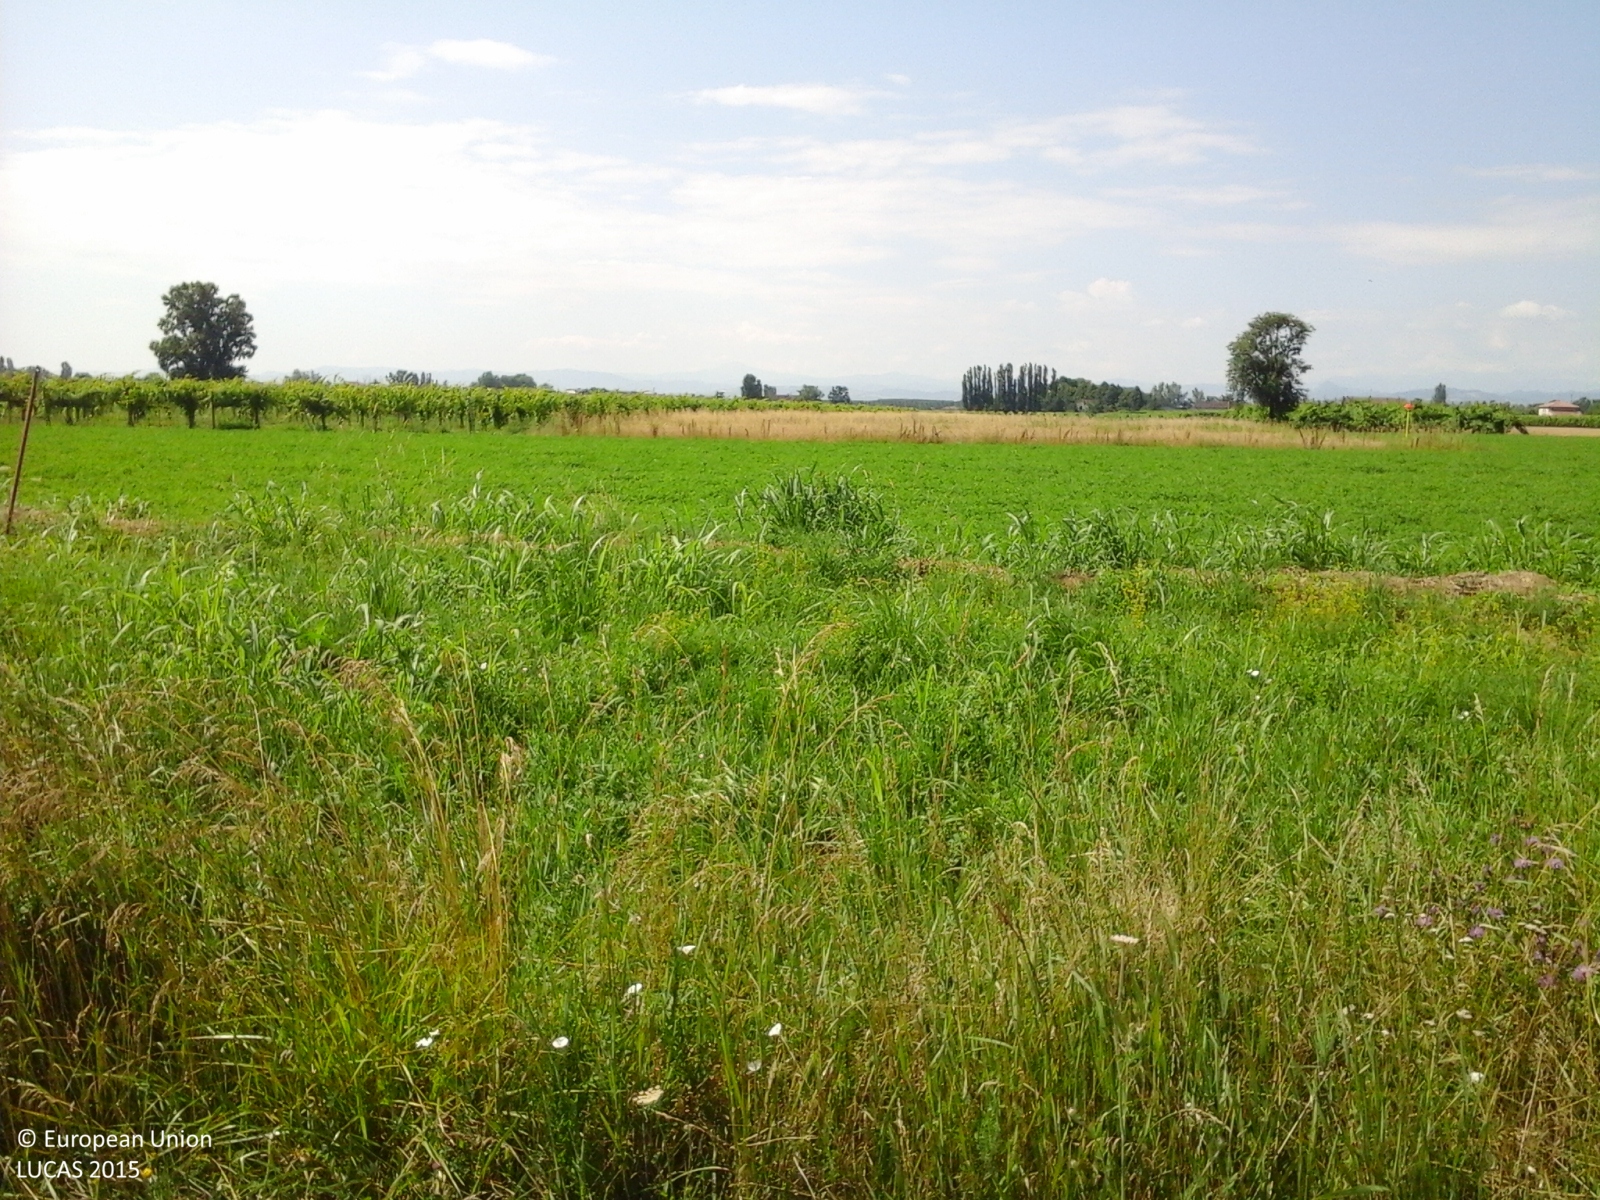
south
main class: Cropland
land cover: Durum wheat
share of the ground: > 75 %
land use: Agriculture (excluding fallow land and kitchen gardens)
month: June
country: IT
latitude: 44.7266
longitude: 10.7434
